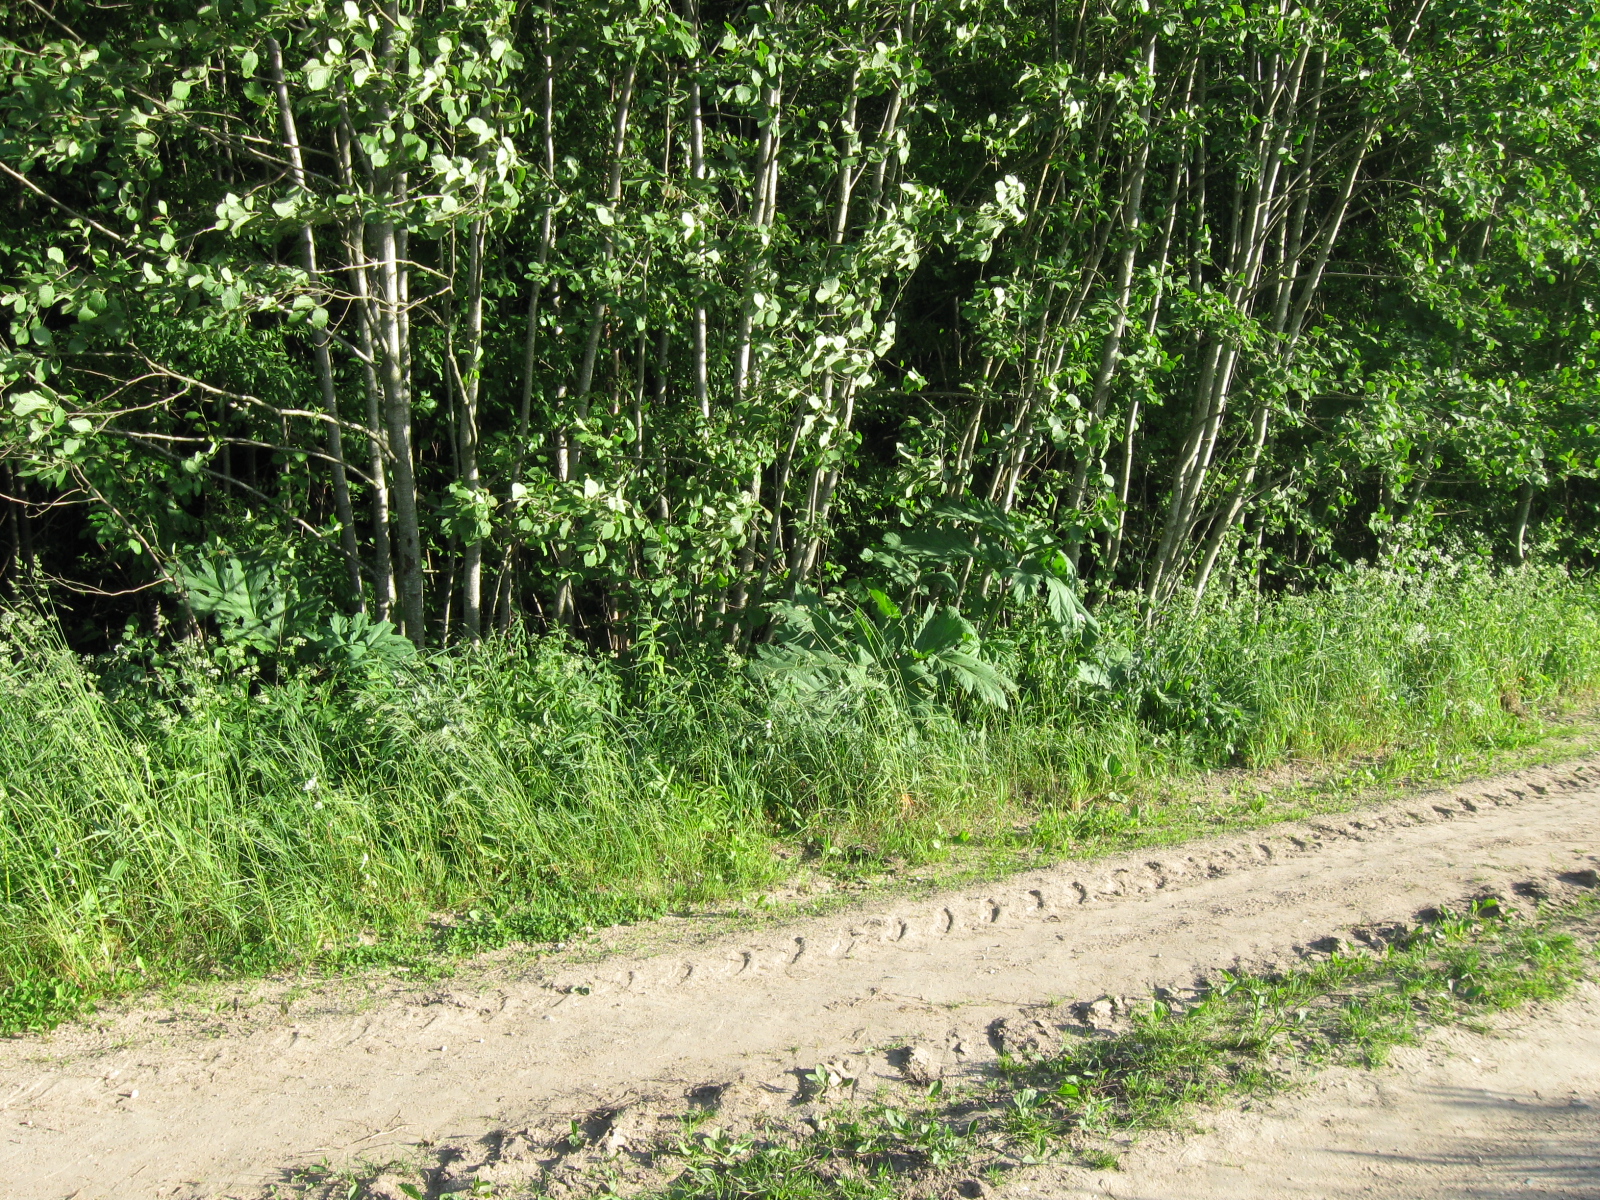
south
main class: Cropland
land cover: Rape and turnip rape
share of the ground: > 75 %
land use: Agriculture (excluding fallow land and kitchen gardens)
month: June
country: LT
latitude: 55.0453
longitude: 24.0361
